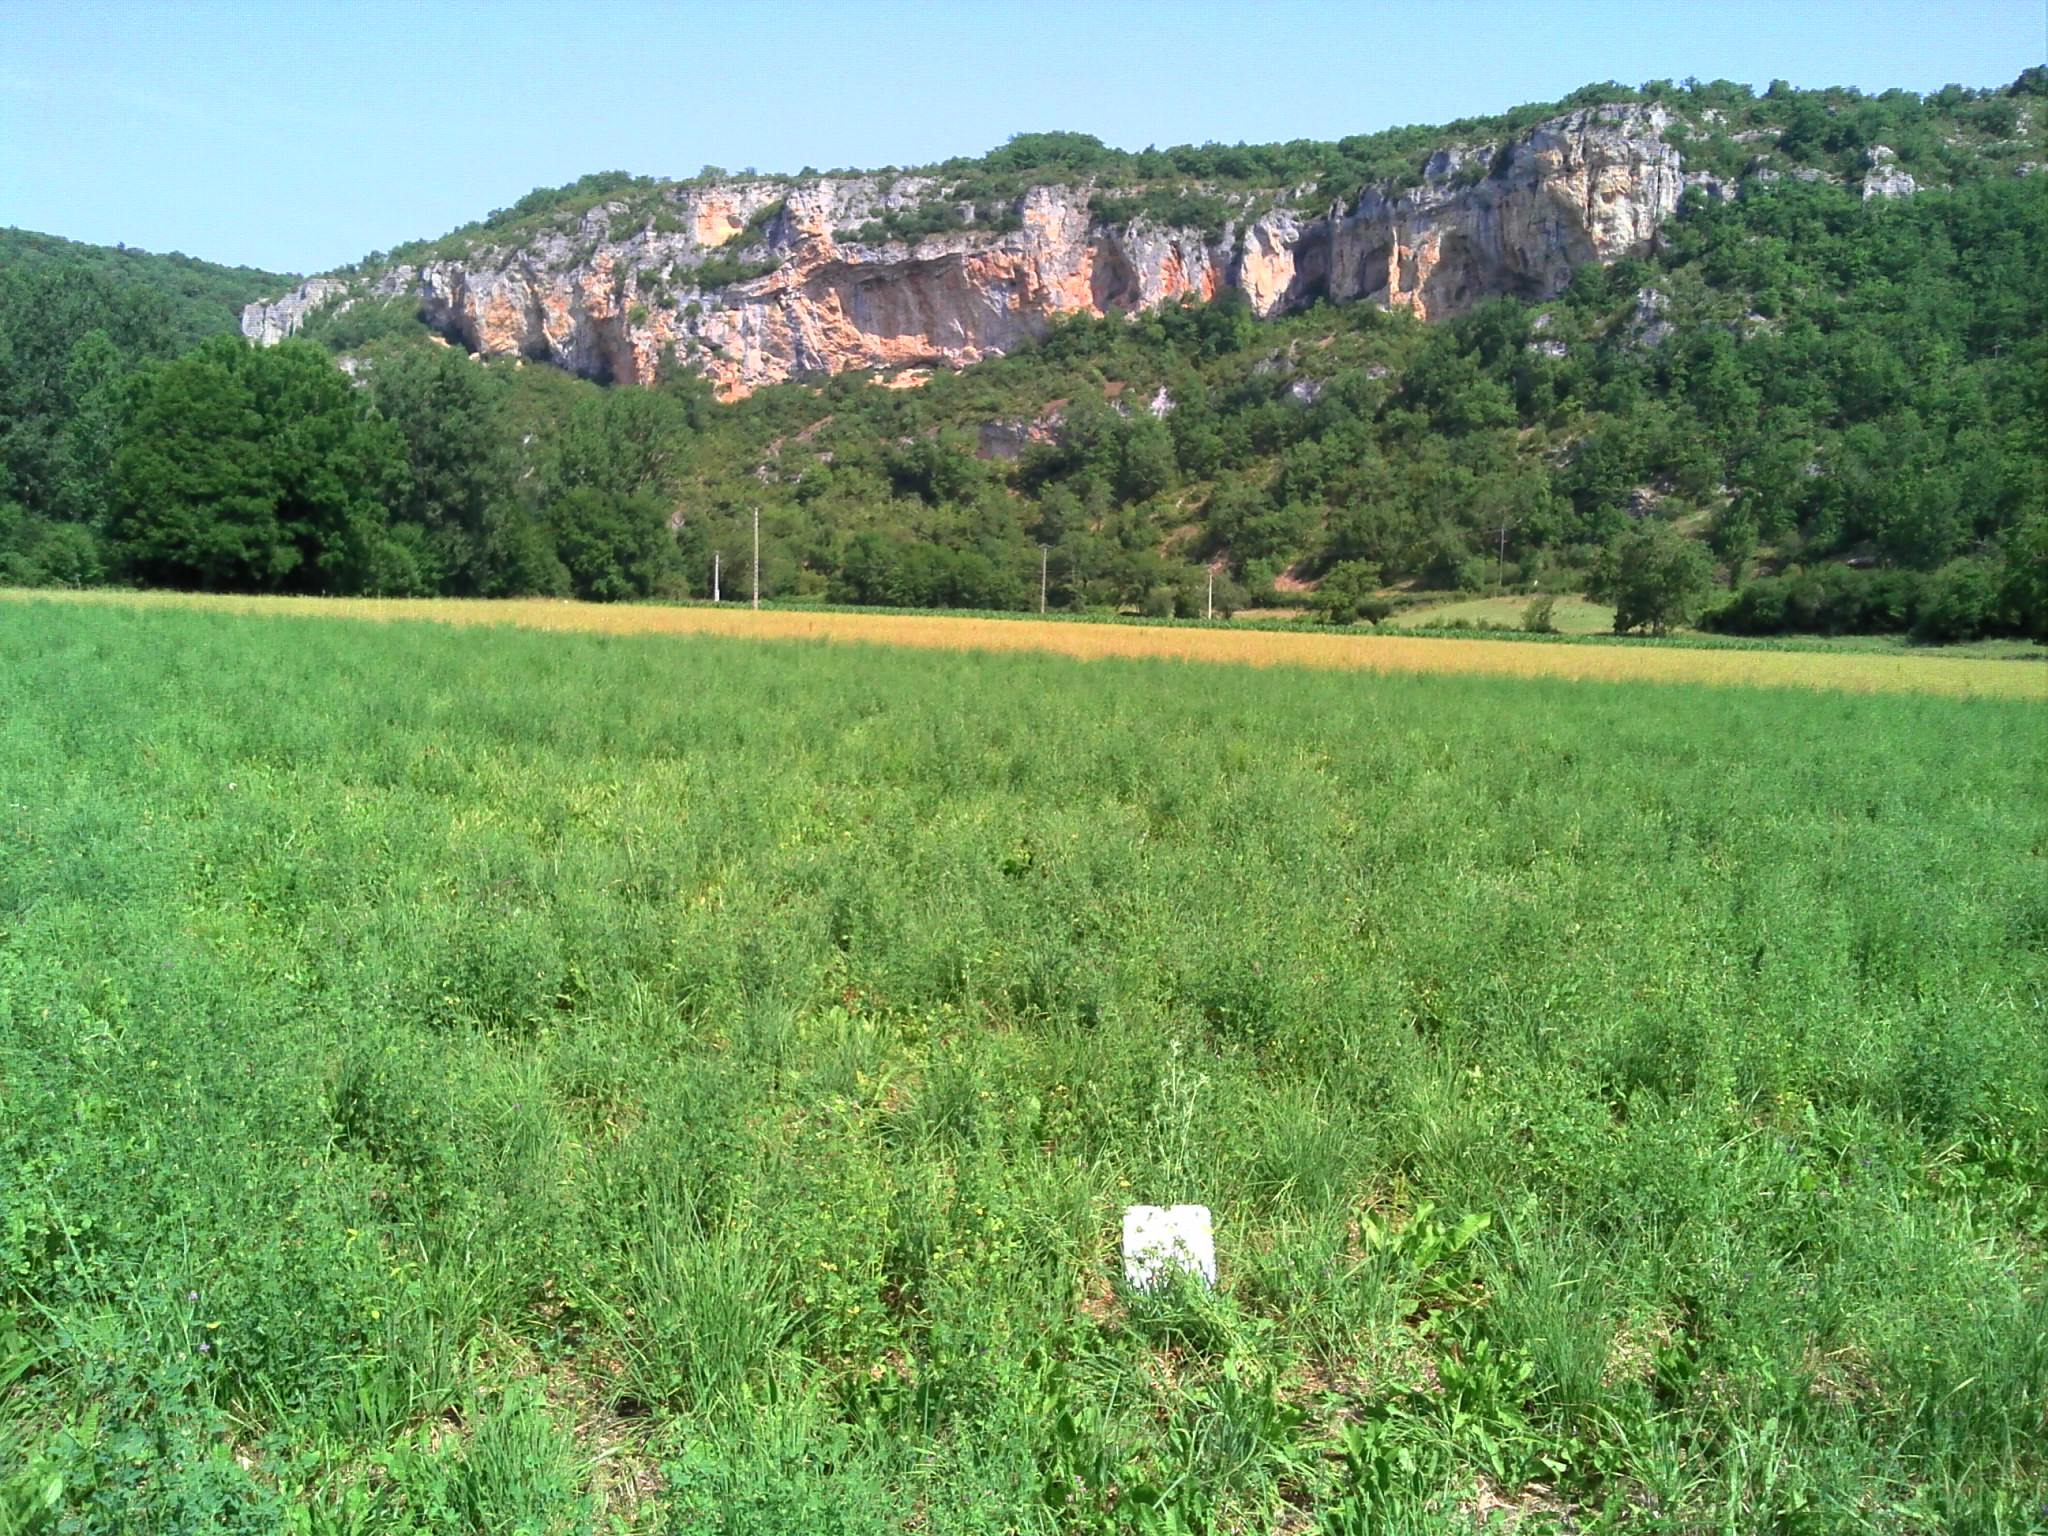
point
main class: Cropland
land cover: Lucerne
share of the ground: > 75 %
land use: Agriculture (excluding fallow land and kitchen gardens)
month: July
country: FR
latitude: 44.5694
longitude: 1.8020
